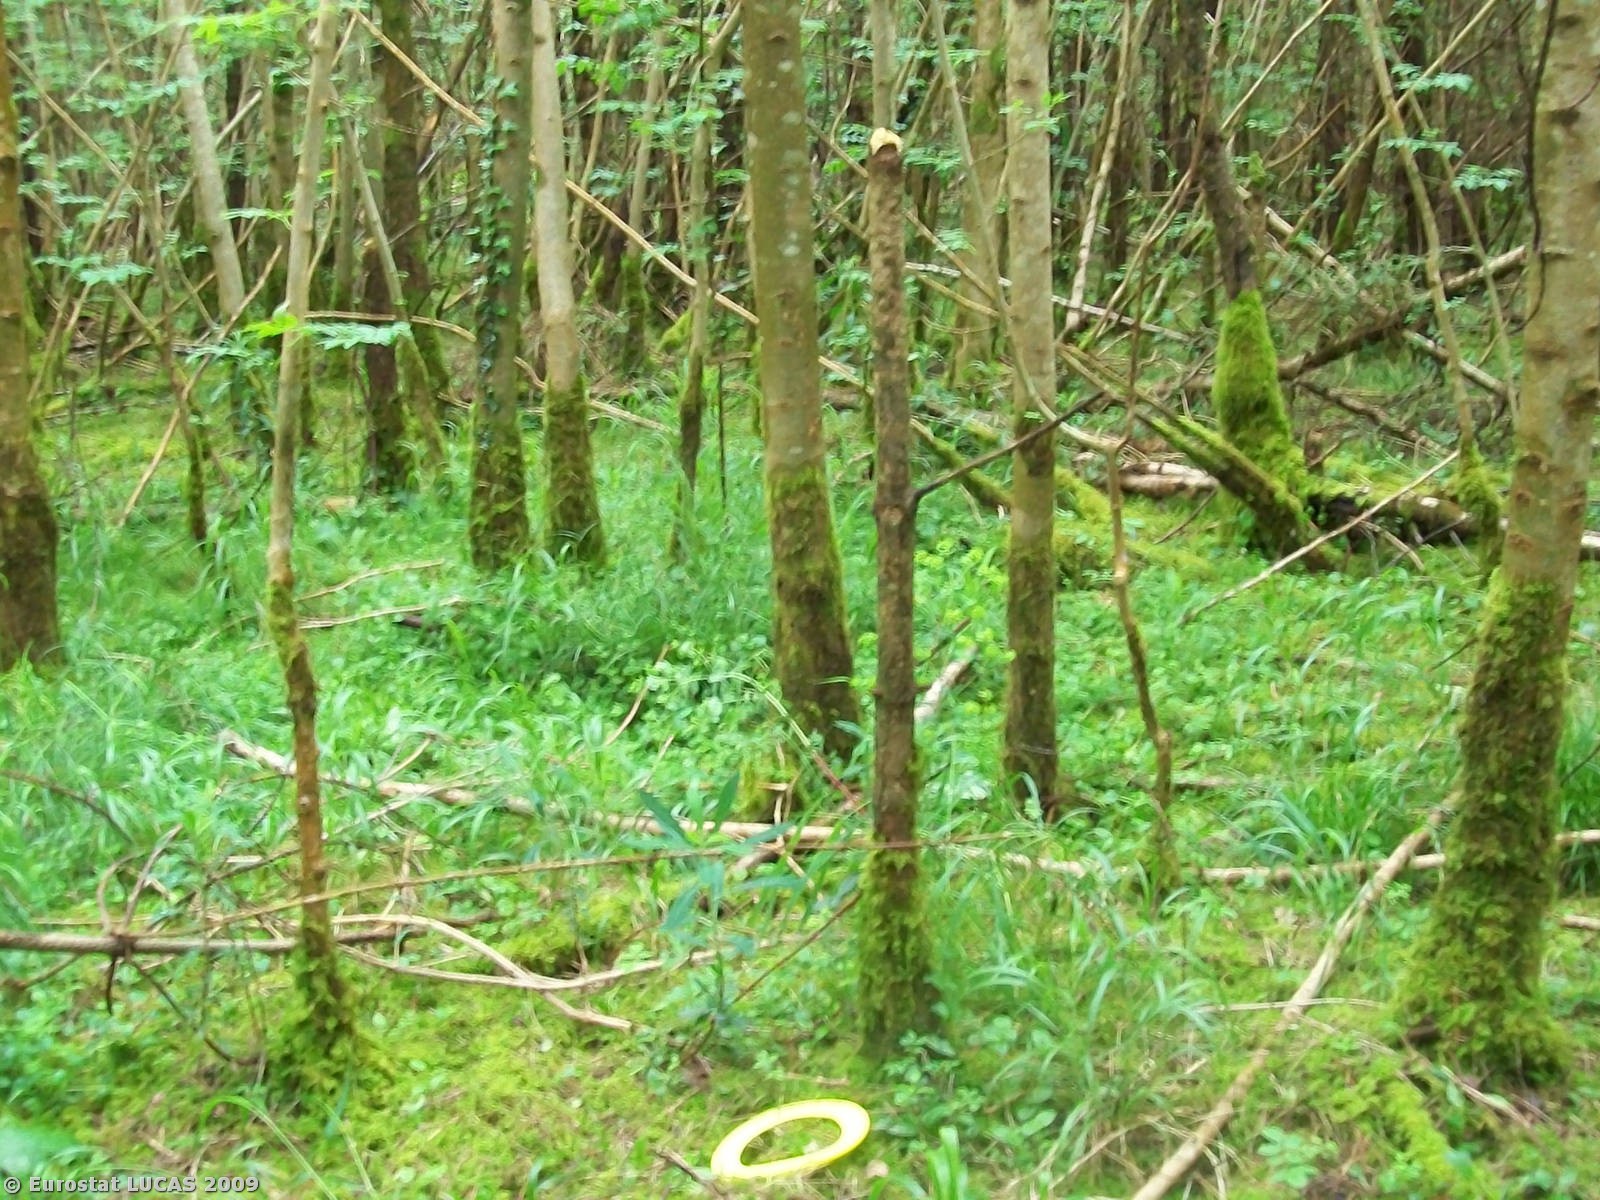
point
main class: Woodland
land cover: Mixed woodland
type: plantations and self-sown exotic forest
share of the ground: > 75 %
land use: Forestry
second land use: Wood based products
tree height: > 5 m
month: May
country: GB
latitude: 50.7923
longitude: -3.4031
